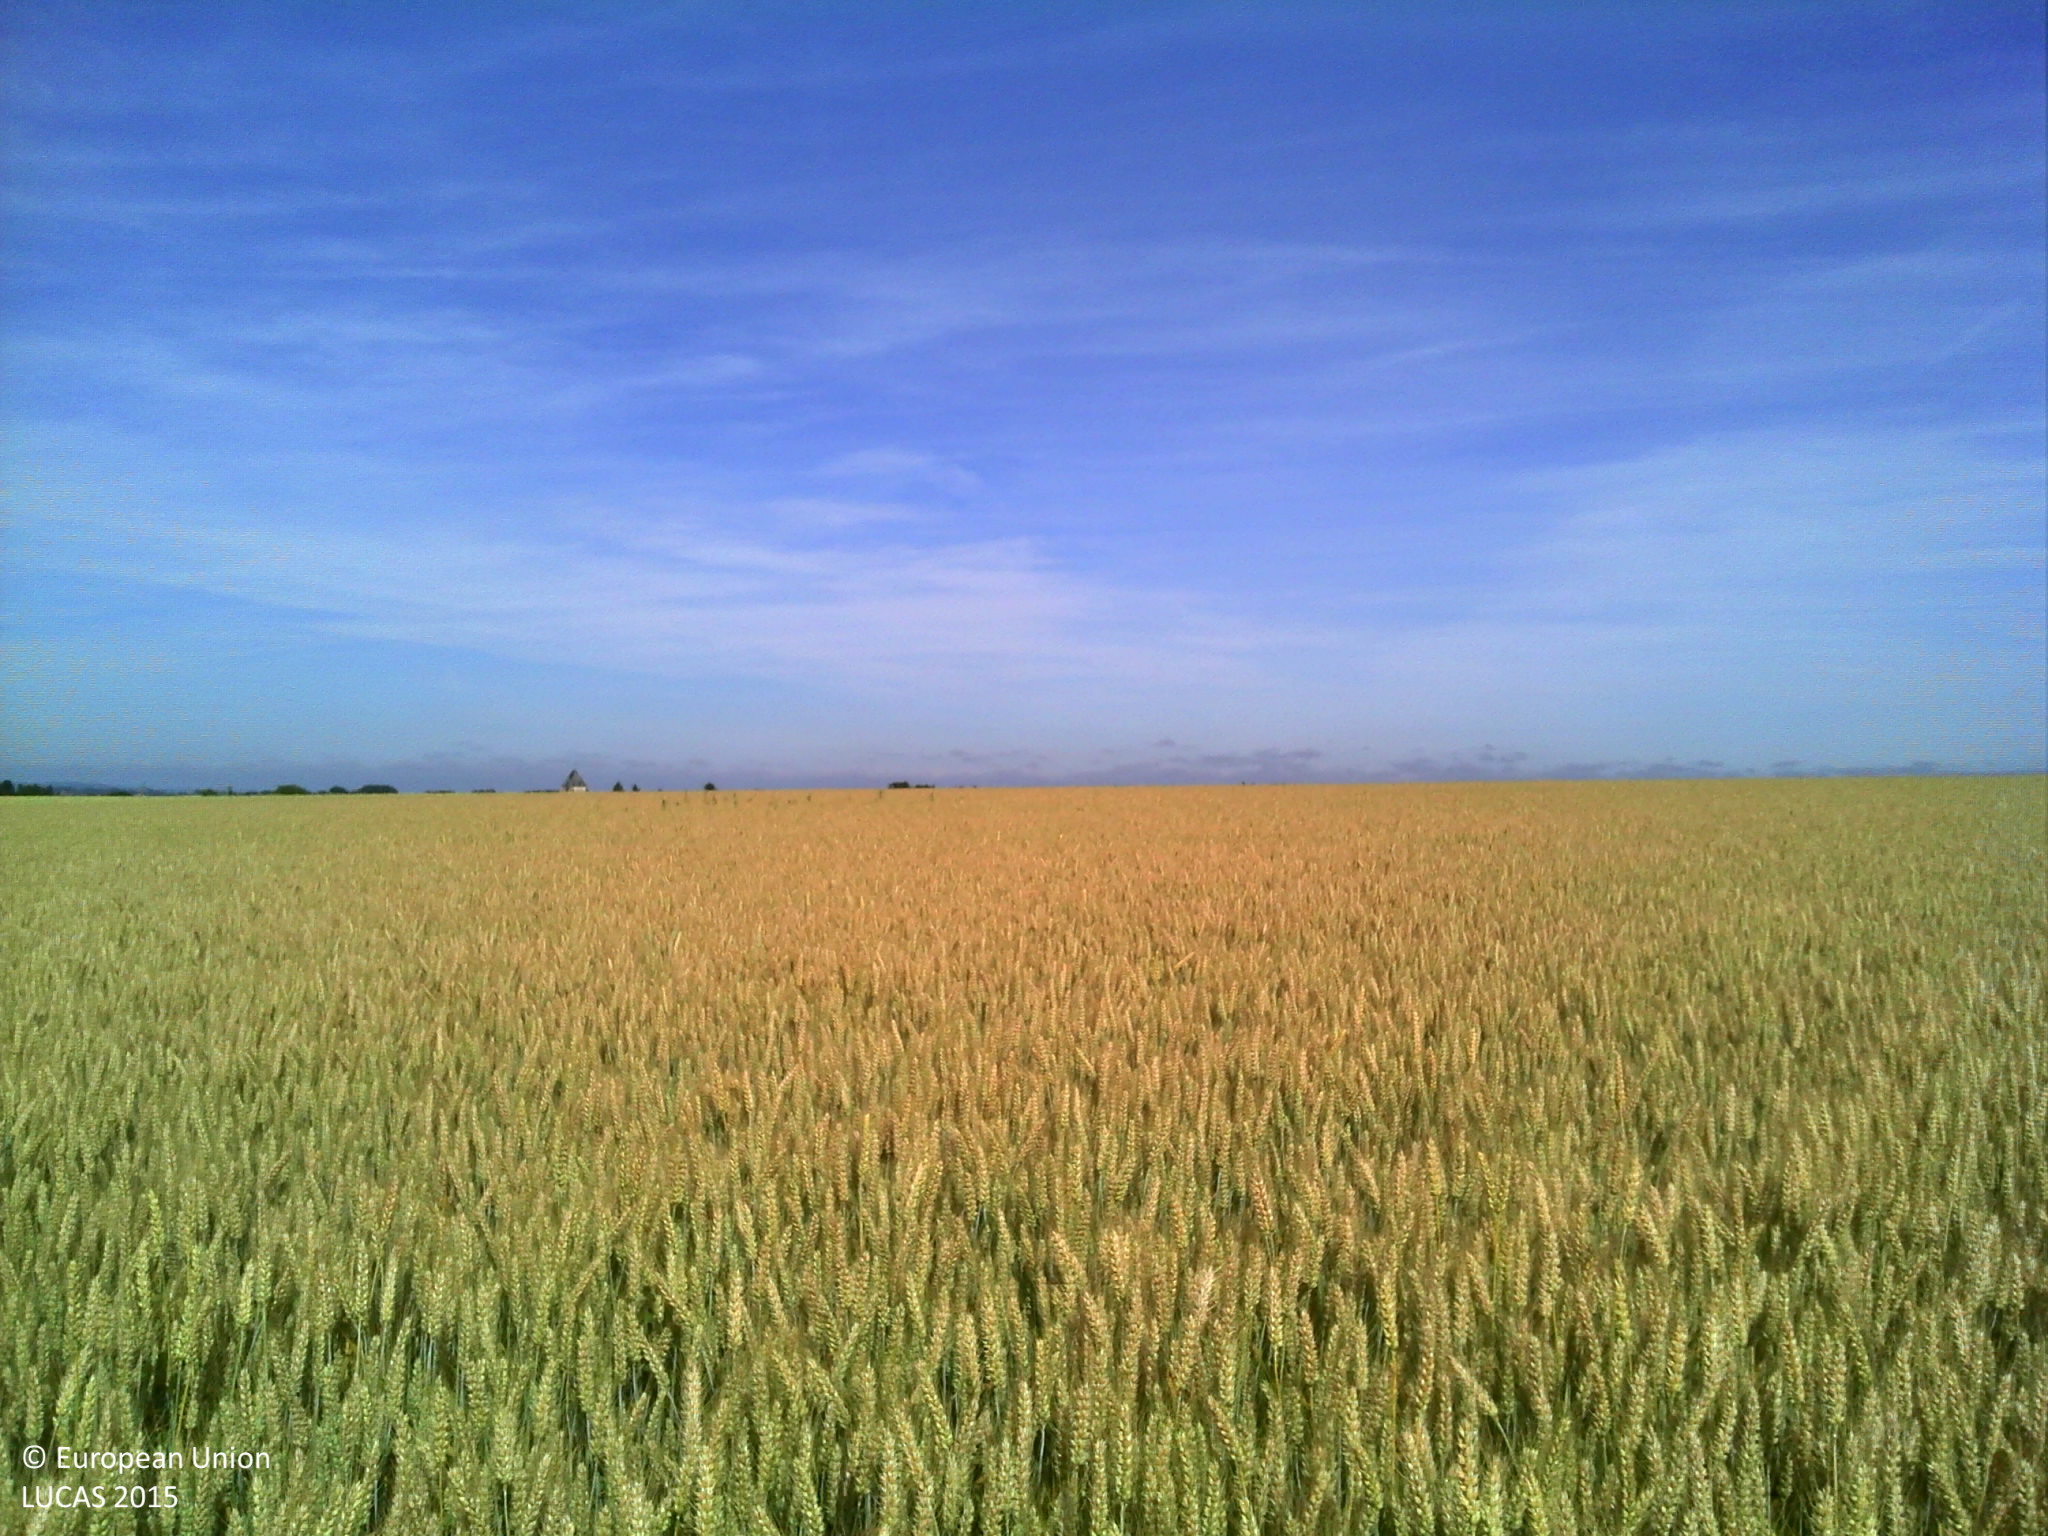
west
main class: Cropland
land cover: Triticale
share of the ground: > 75 %
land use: Agriculture (excluding fallow land and kitchen gardens)
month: June
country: FR
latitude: 48.2780
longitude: 0.2309
